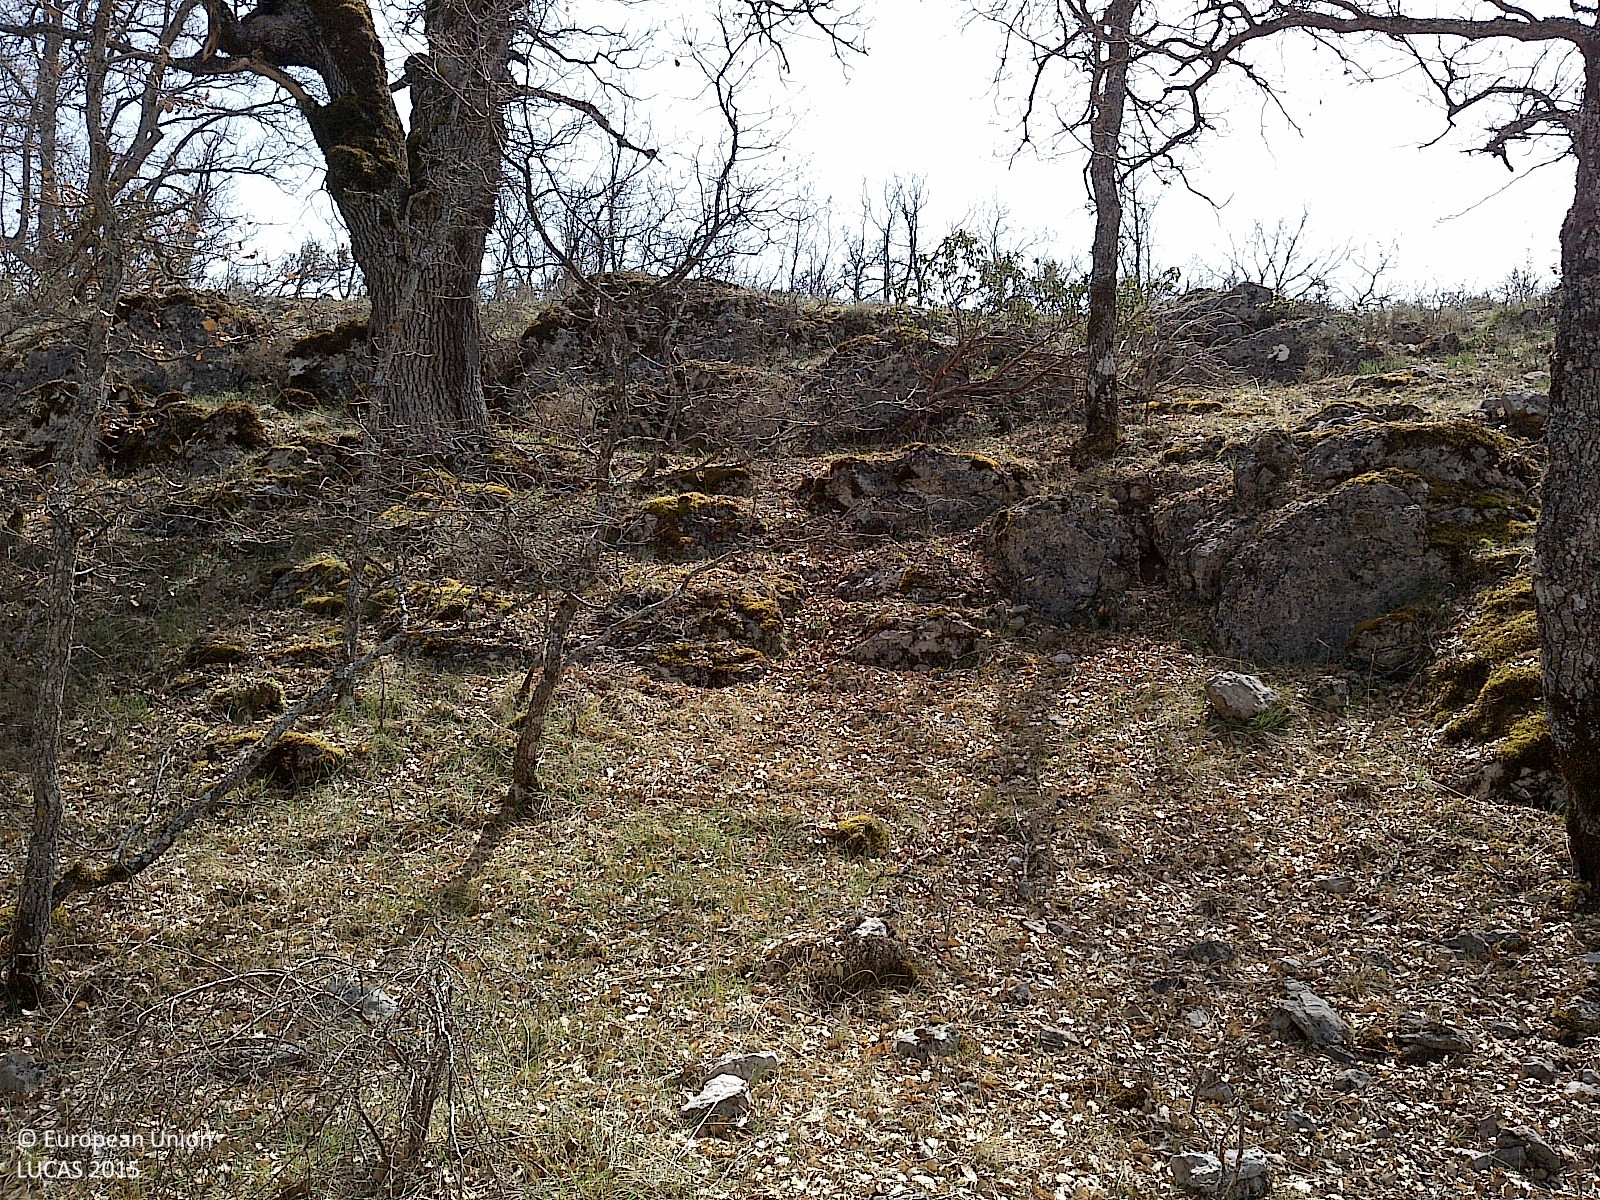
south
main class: Woodland
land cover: Broadleaved woodland
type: thermophilous deciduous forest
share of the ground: 50 - 75 %
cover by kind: broadleaved forest trees 50 %, herbaceous plants 30 %, shrubs 20 %
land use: Forestry
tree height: > 5 m
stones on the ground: 10 - 25 %
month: April
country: ES
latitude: 42.0962
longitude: -3.3406
